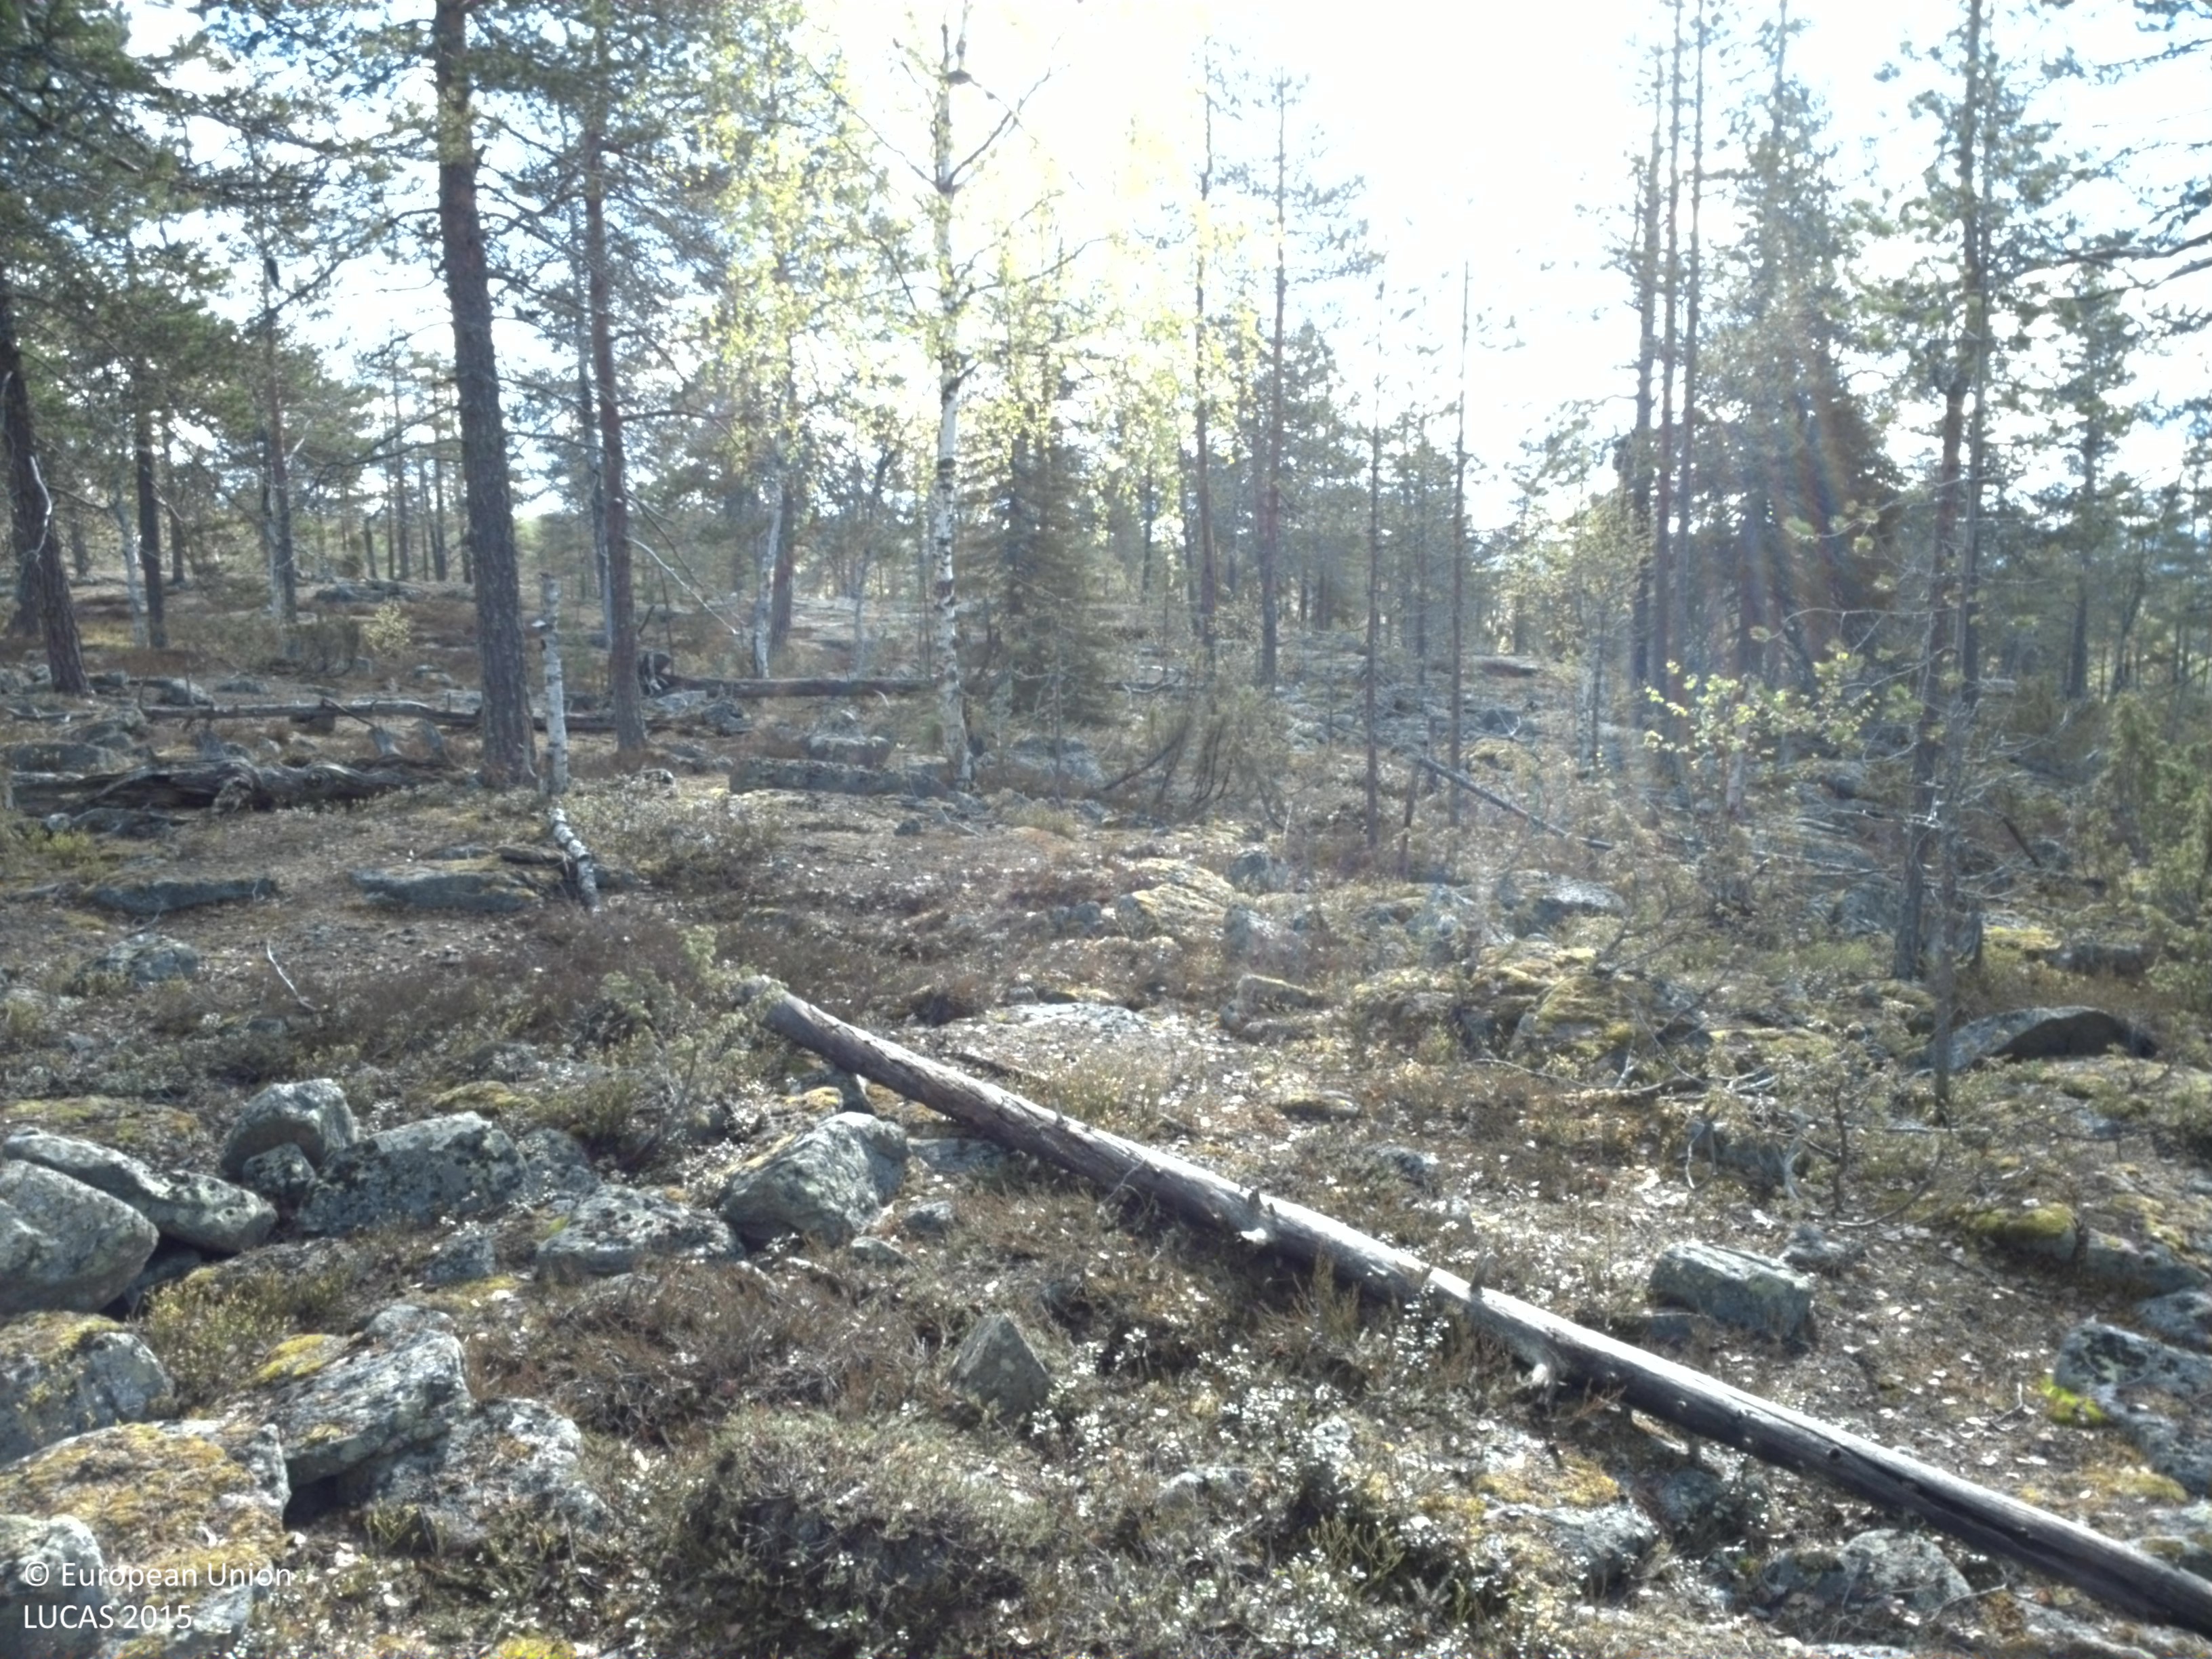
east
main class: Woodland
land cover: Pine dominated coniferous woodland
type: boreal forest
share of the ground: 25 - 50 %
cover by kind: shrubs 45 %, coniferous forest trees 35 %, lichens and mosses 10 %, consolidated bare surface 10 %
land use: Forestry
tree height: > 5 m
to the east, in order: Pine dominated coniferous woodland; Spruce dominated mixed woodland
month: June
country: SE
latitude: 66.4100
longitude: 23.5337
